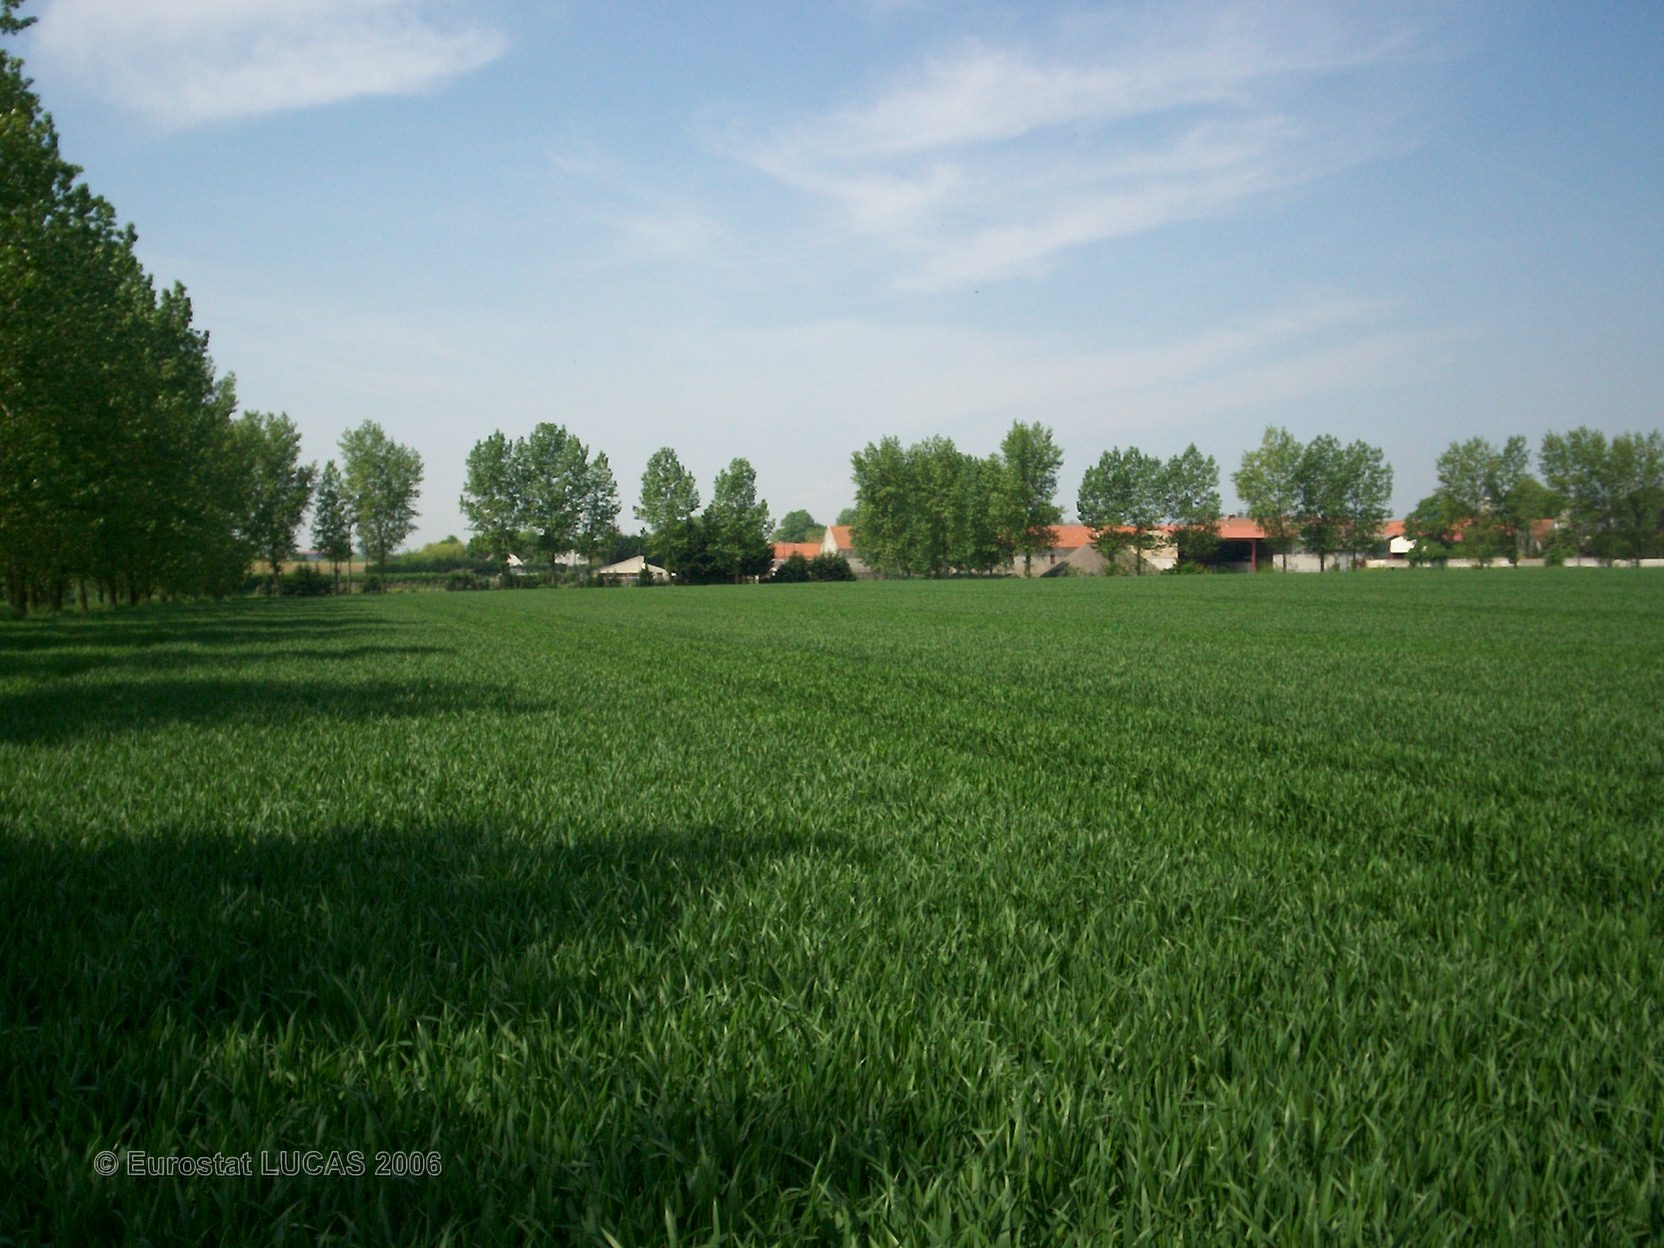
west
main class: Cropland
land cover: Common wheat
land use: Agriculture (excluding fallow land and kitchen gardens)
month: May
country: FR
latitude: 48.9807
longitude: 2.7894
